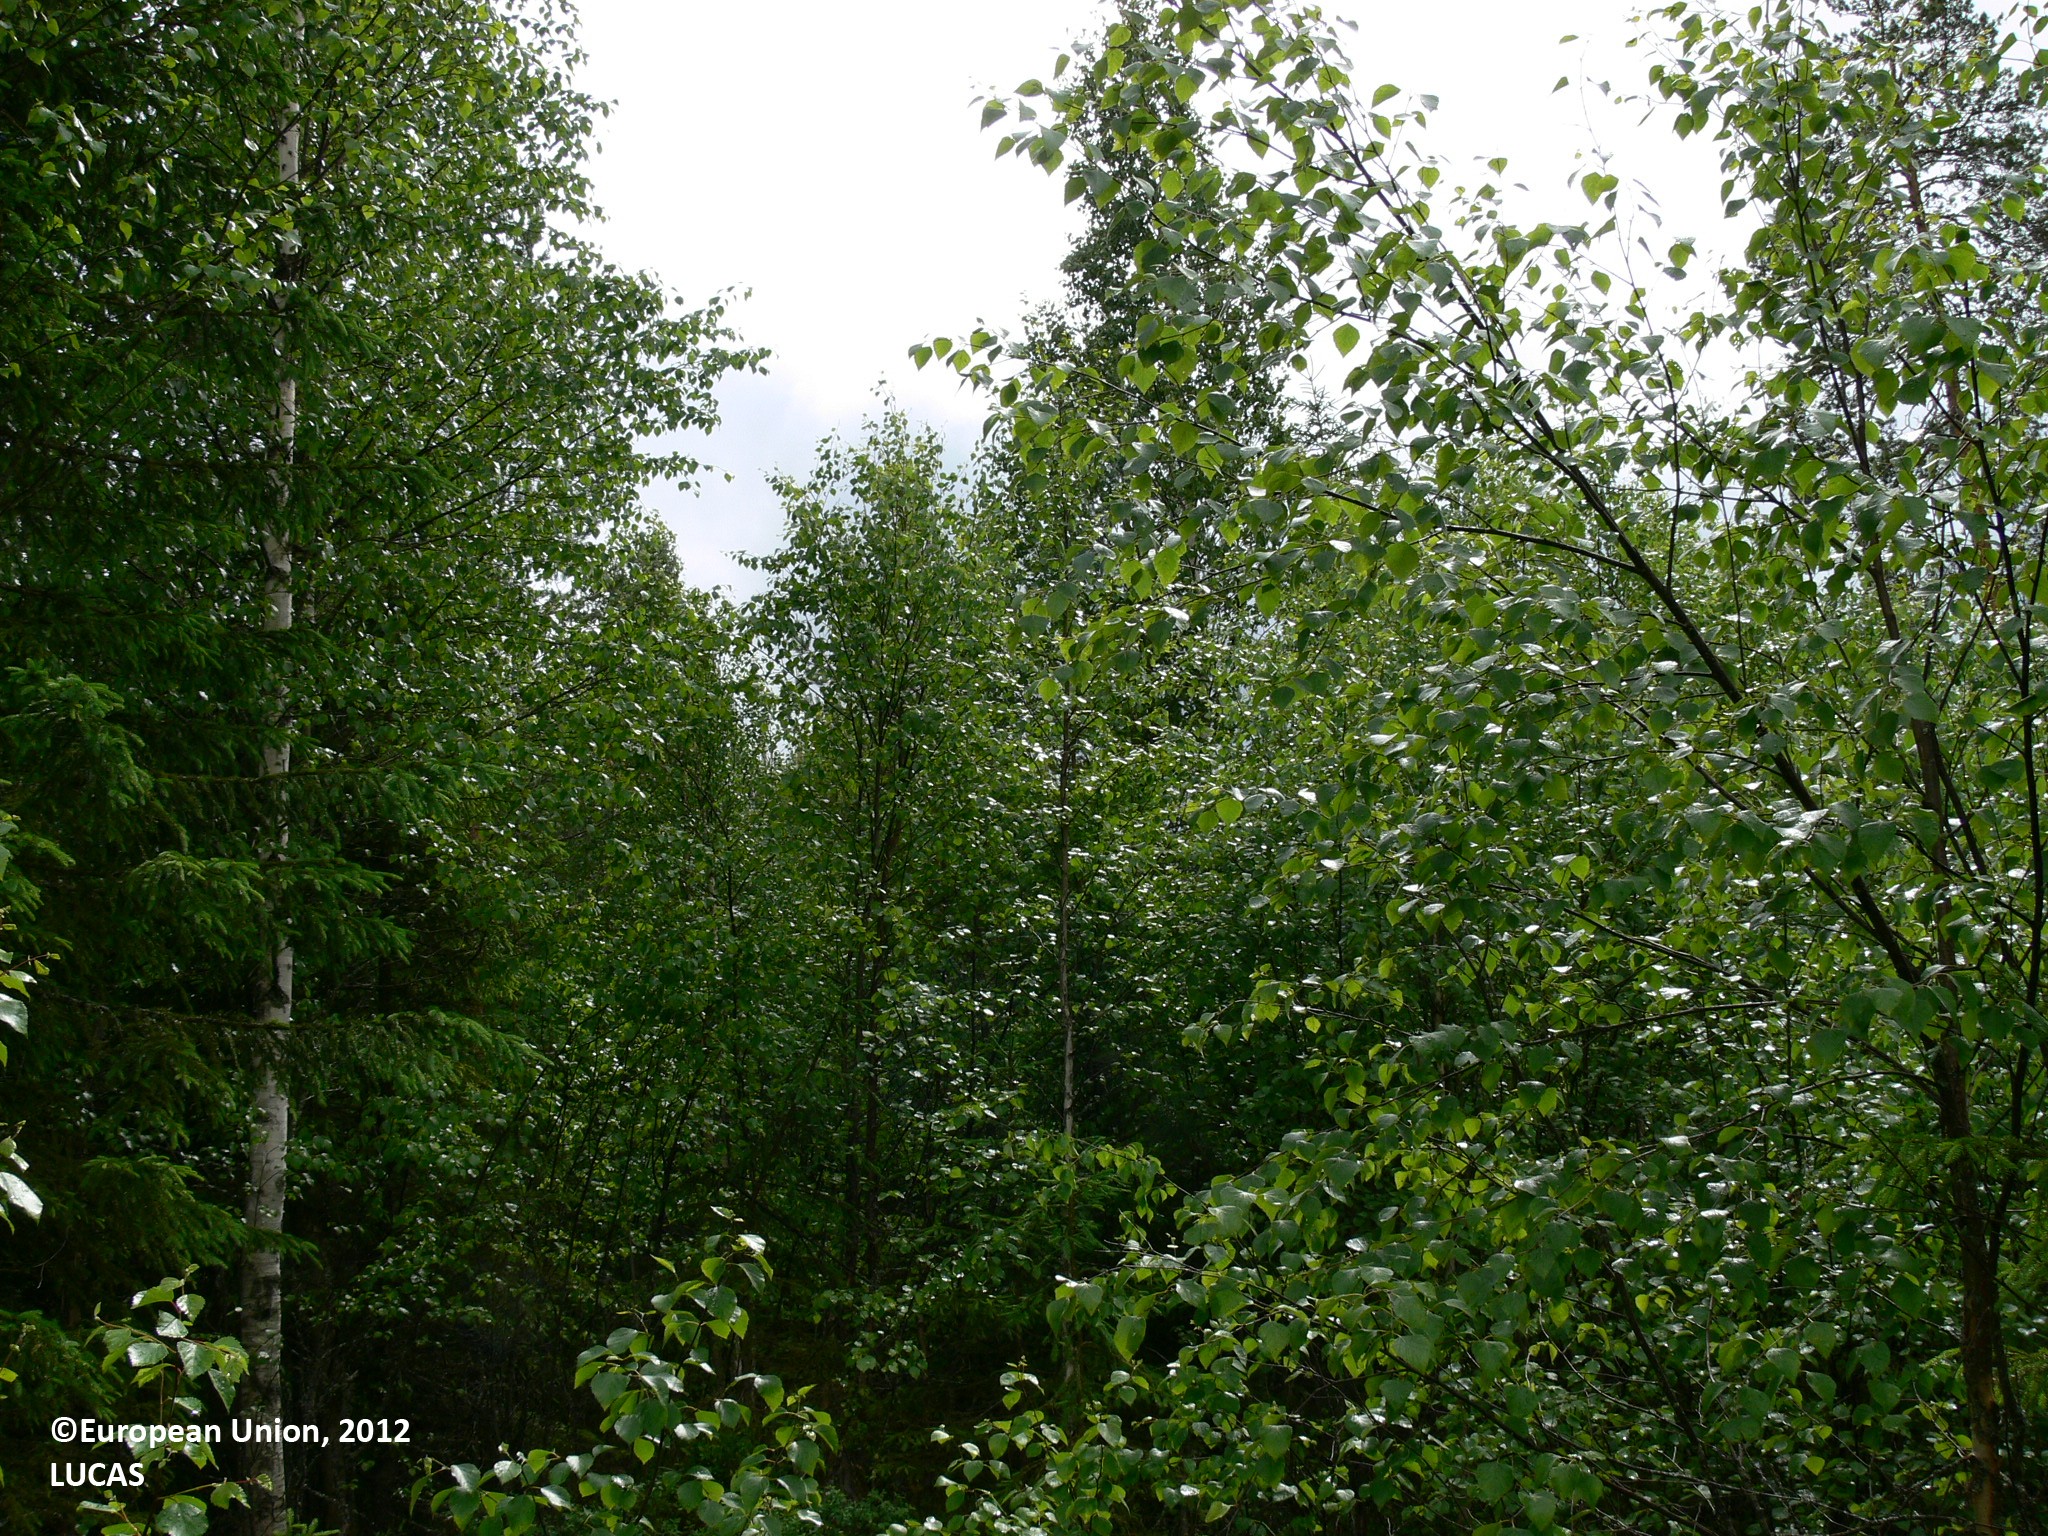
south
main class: Woodland
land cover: Other mixed woodland
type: boreal forest
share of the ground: 50 - 75 %
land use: Forestry
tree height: > 5 m
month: June
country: FI
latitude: 62.9126
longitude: 29.3013
